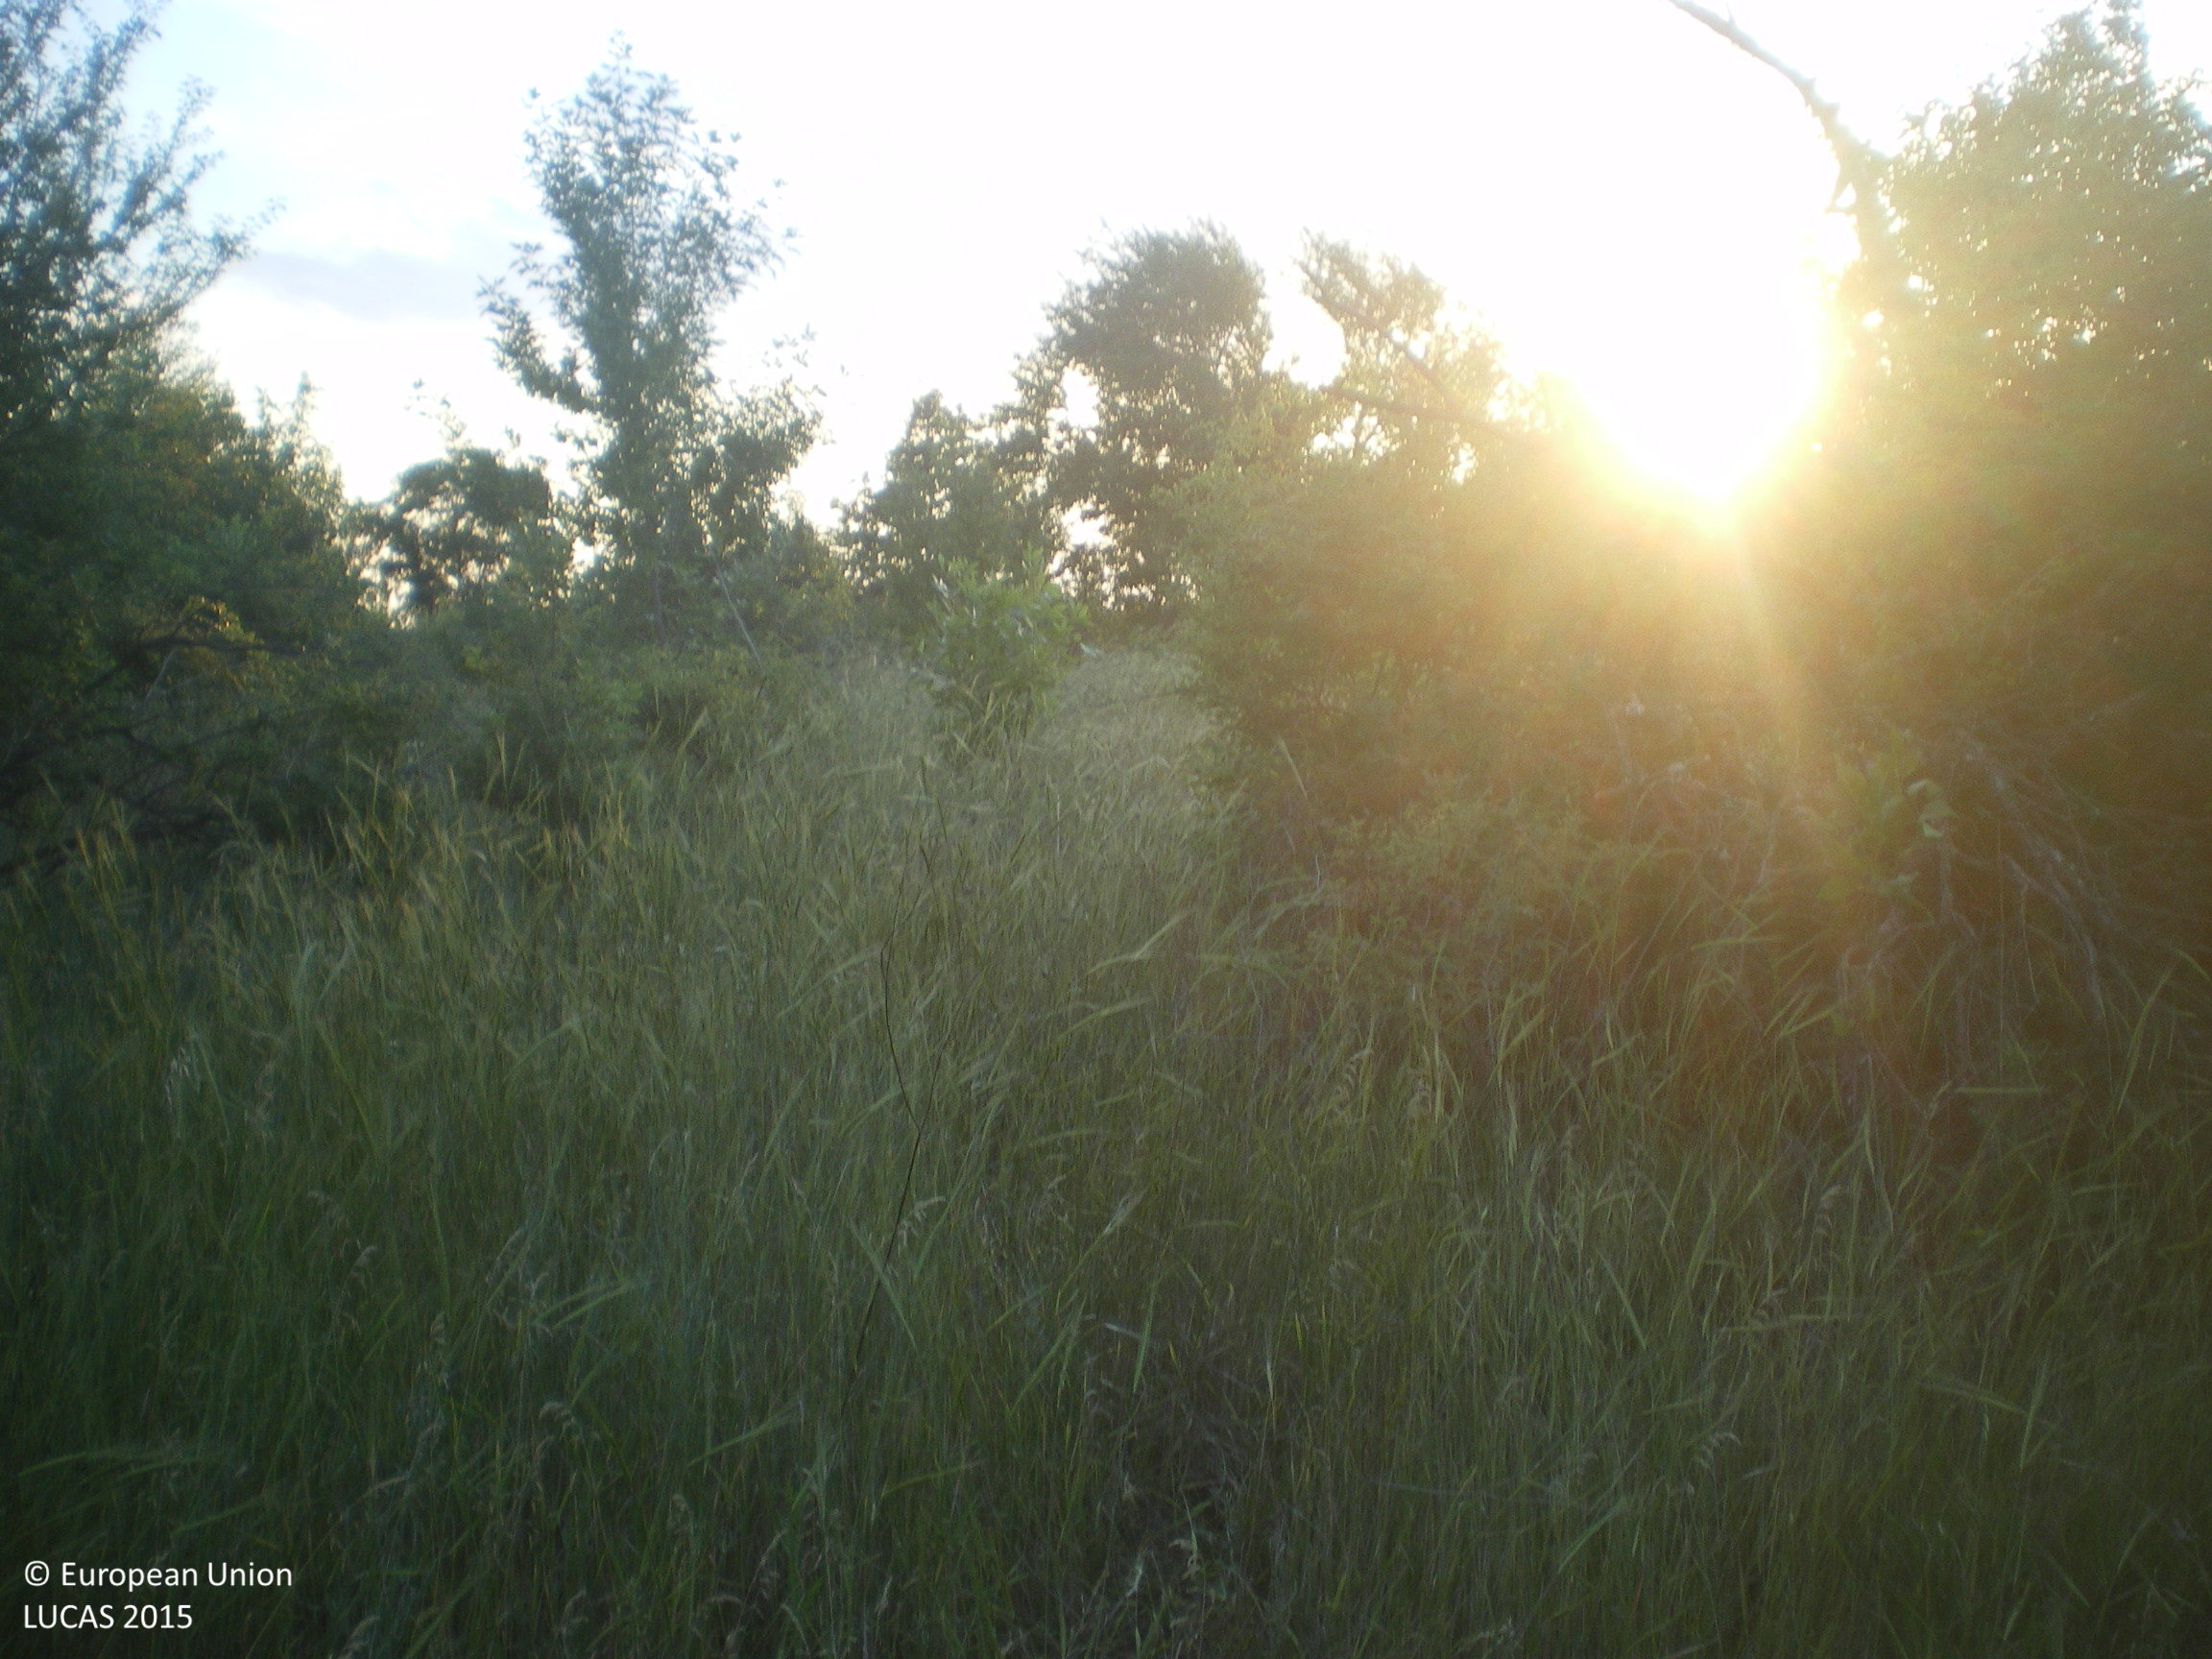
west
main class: Woodland
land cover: Broadleaved woodland
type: mesophytic deciduous forest
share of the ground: 25 - 50 %
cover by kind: broadleaved forest trees 50 %, herbaceous plants 35 %, shrubs 15 %
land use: Semi-natural and natural areas not in use
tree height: > 5 m
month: June
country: BG
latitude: 42.3857
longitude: 25.1600
